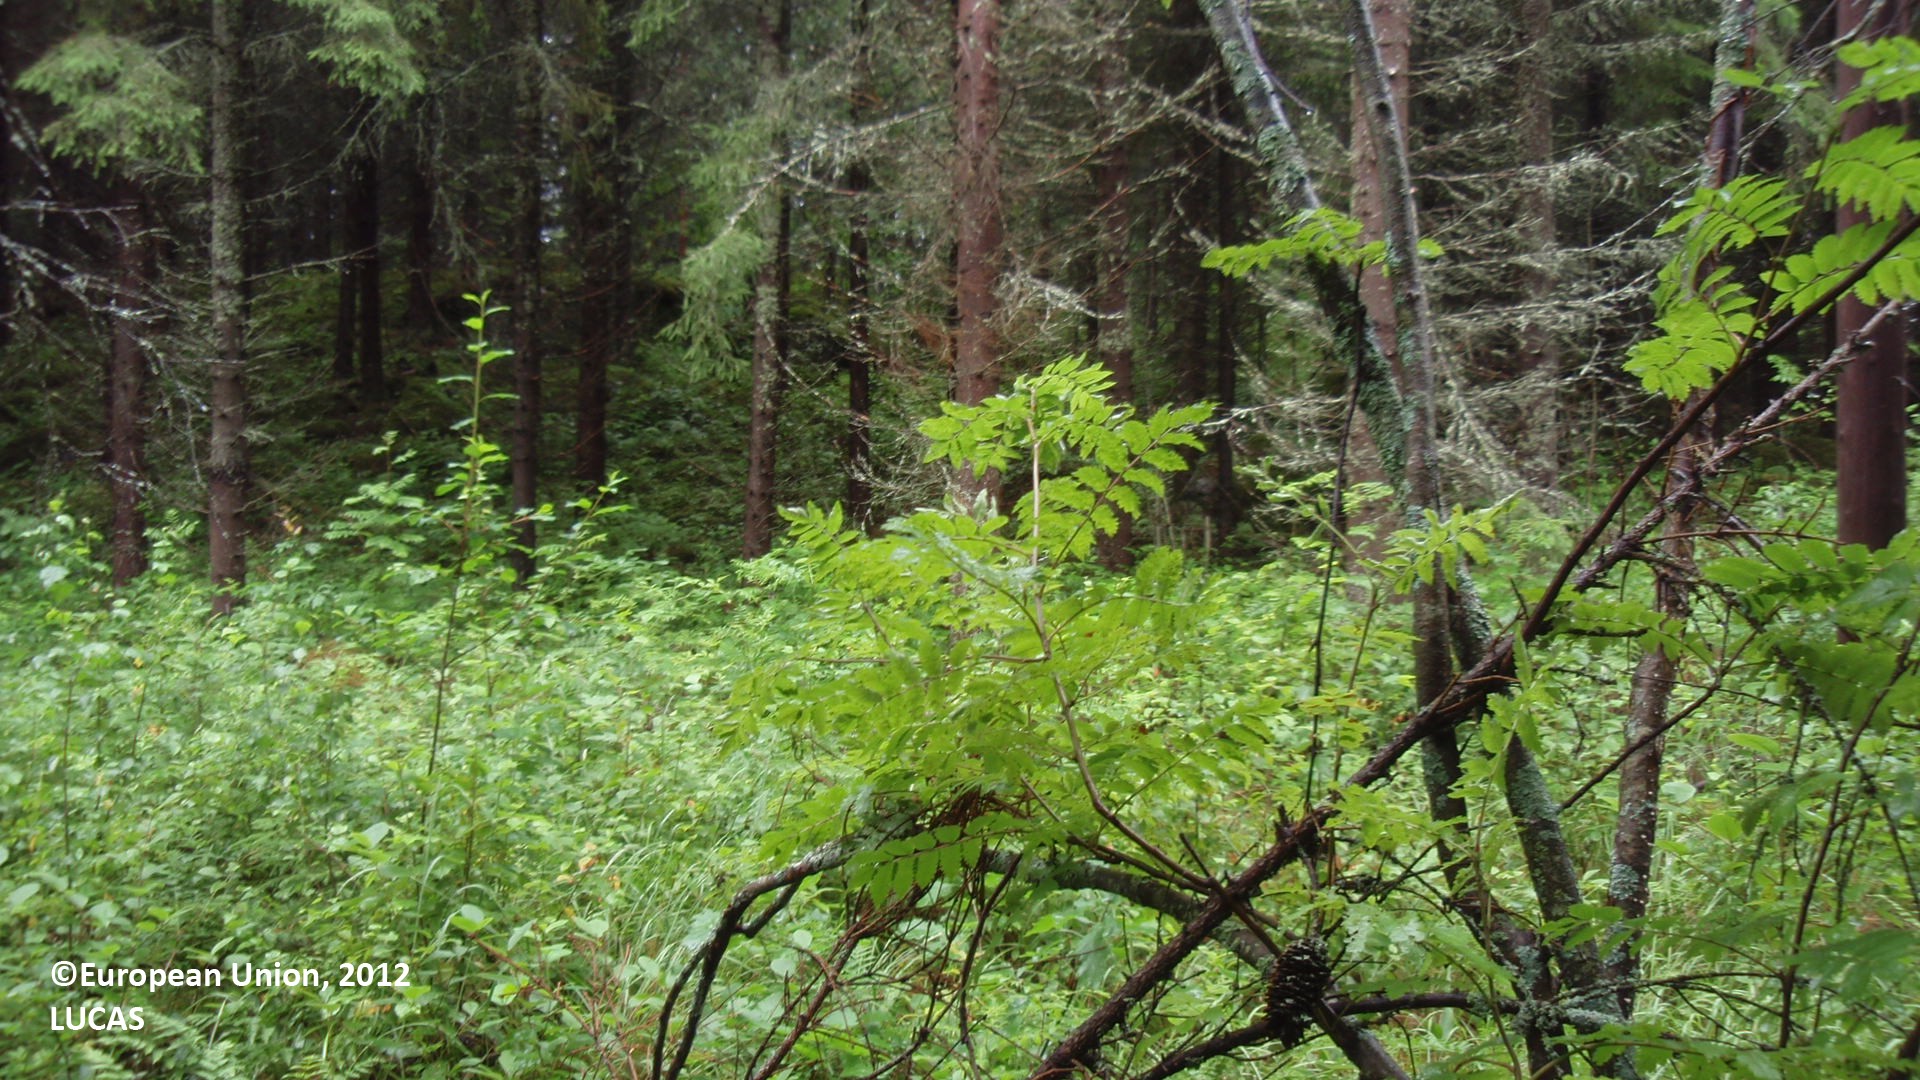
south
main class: Woodland
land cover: Spruce dominated coniferous woodland
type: boreal forest
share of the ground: > 75 %
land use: Forestry
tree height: > 5 m
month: July
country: FI
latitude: 61.6373
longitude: 27.2844
